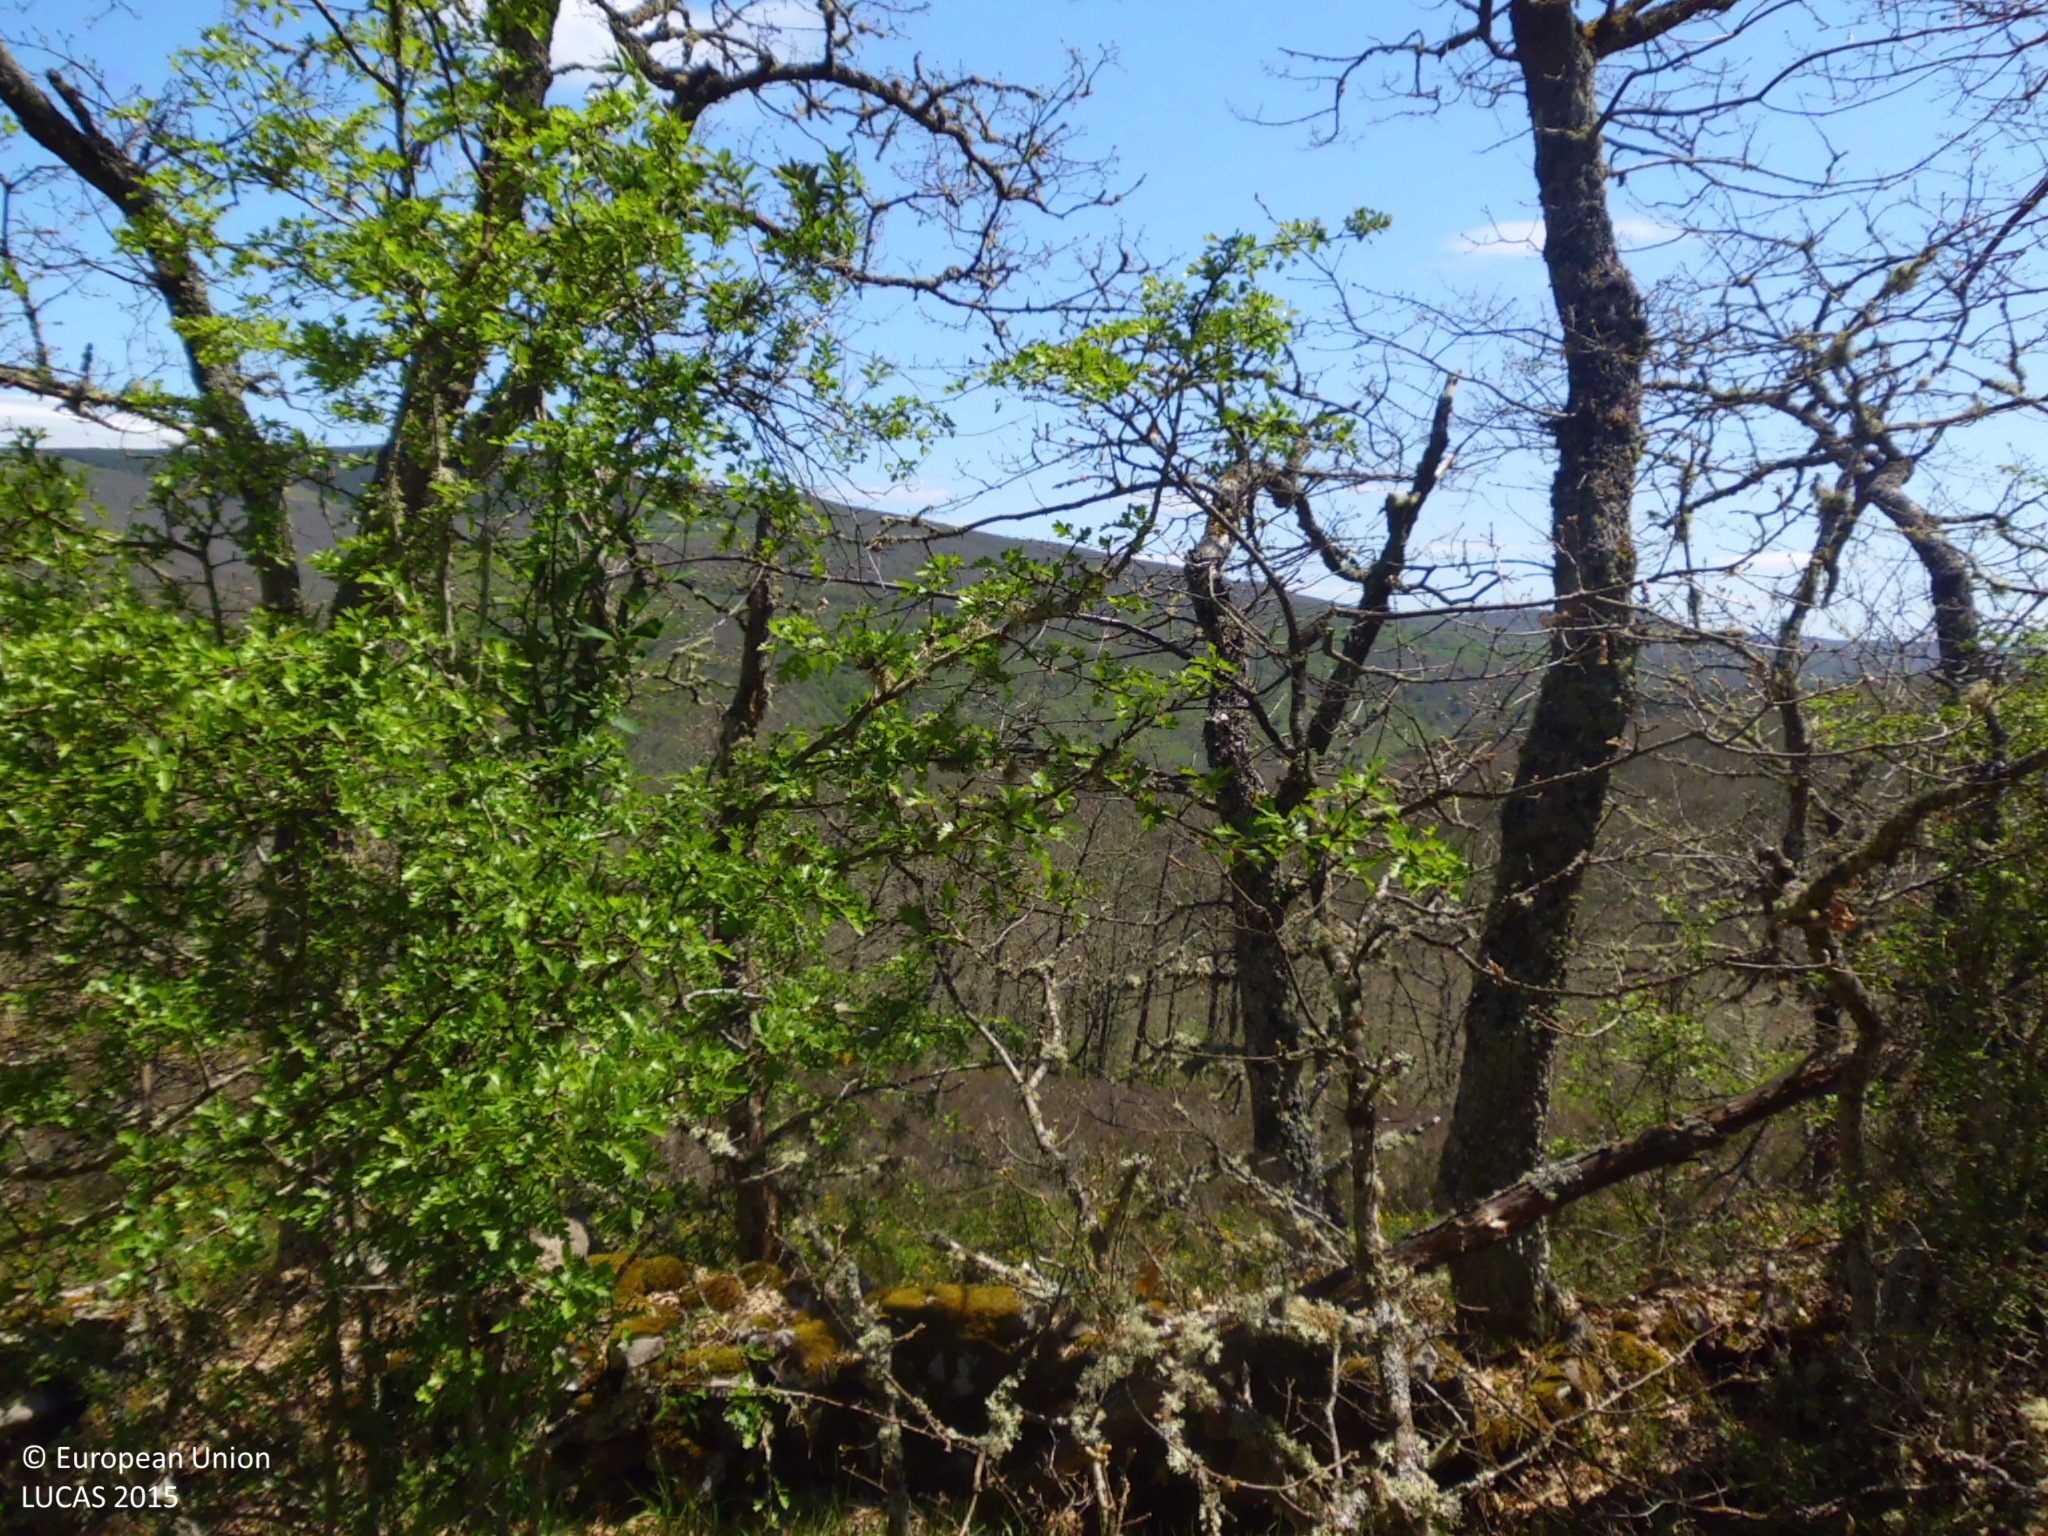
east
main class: Woodland
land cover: Broadleaved woodland
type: acidophilous oak and oak-birch forest
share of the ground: 50 - 75 %
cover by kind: broadleaved forest trees 65 %, herbaceous plants 20 %, shrubs 15 %
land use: Semi-natural and natural areas not in use
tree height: > 5 m
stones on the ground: 25 - 50 %
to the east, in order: Broadleaved woodland; Grassland without tree/shrub cover; Broadleaved woodland; Grassland with sparse tree/shrub cover; Broadleaved woodland; Grassland without tree/shrub cover; Broadleaved woodland
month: May
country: ES
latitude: 42.8960
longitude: -4.0448
